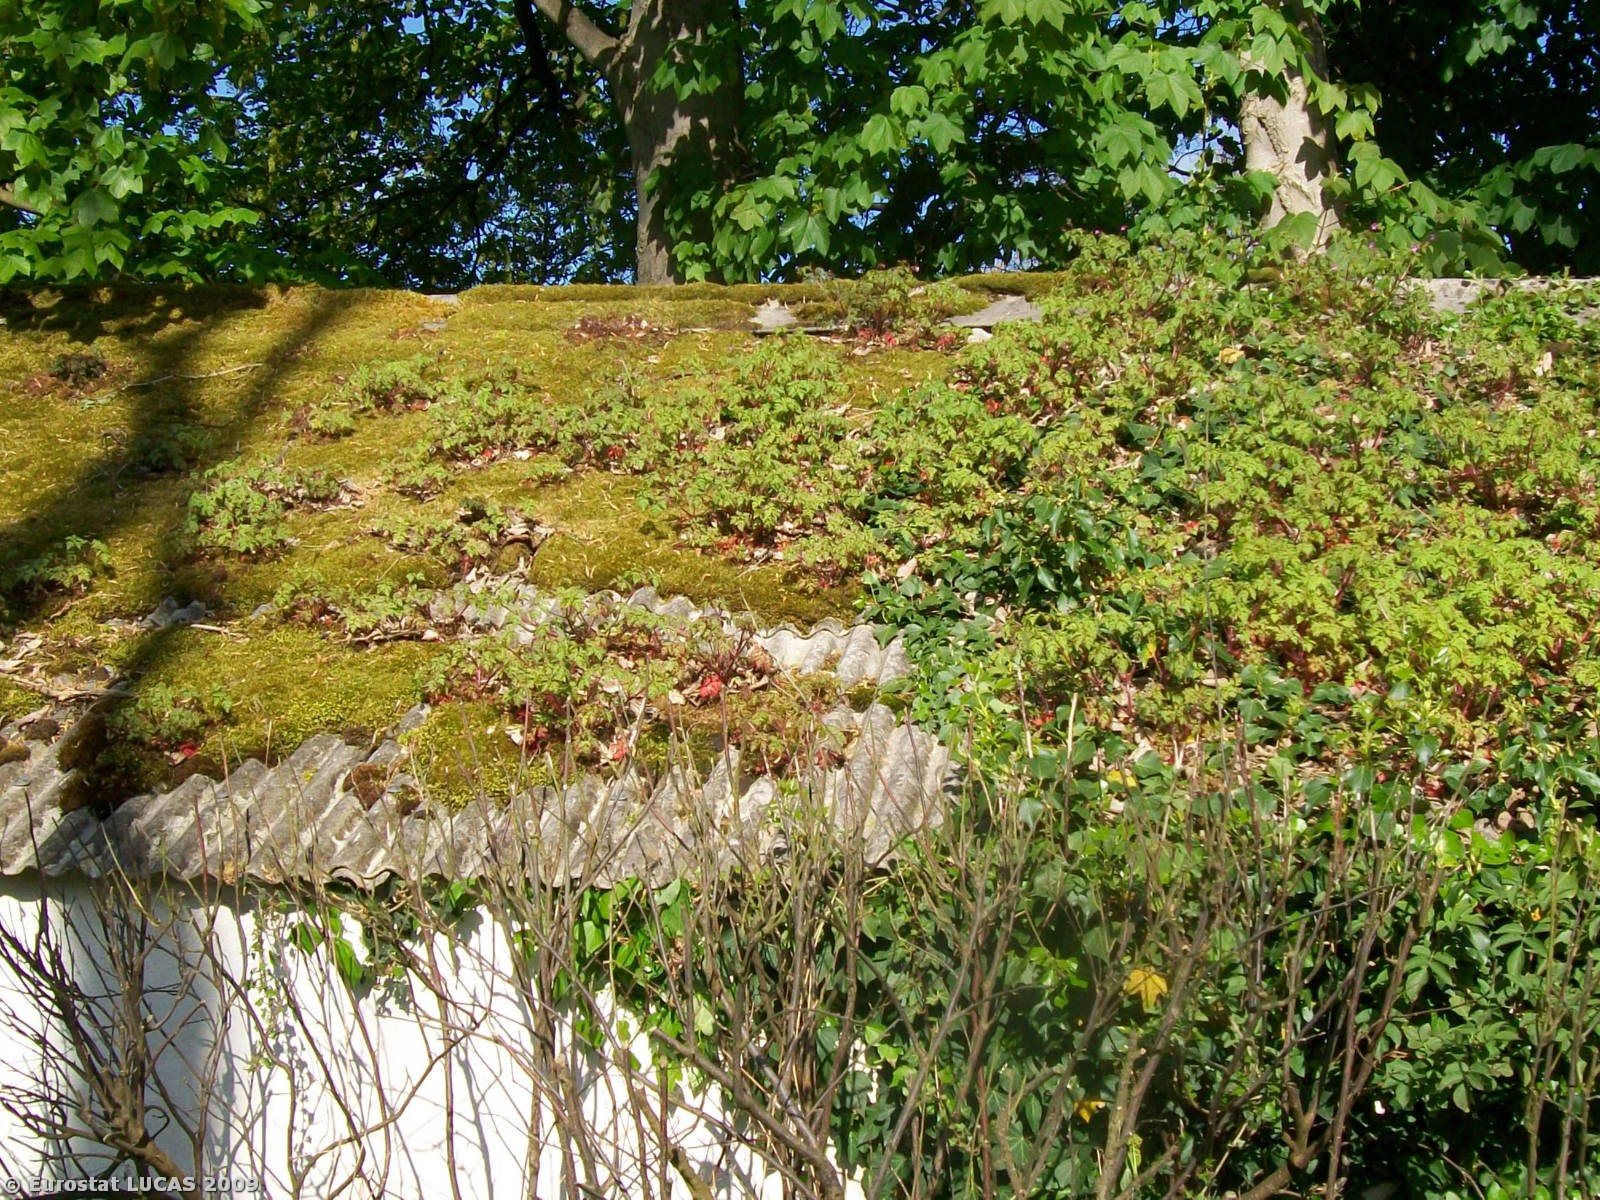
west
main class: Water areas
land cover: Inland running water
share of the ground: 10 - 25 %
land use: Unused
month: May
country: GB
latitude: 53.2372
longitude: -3.5546
